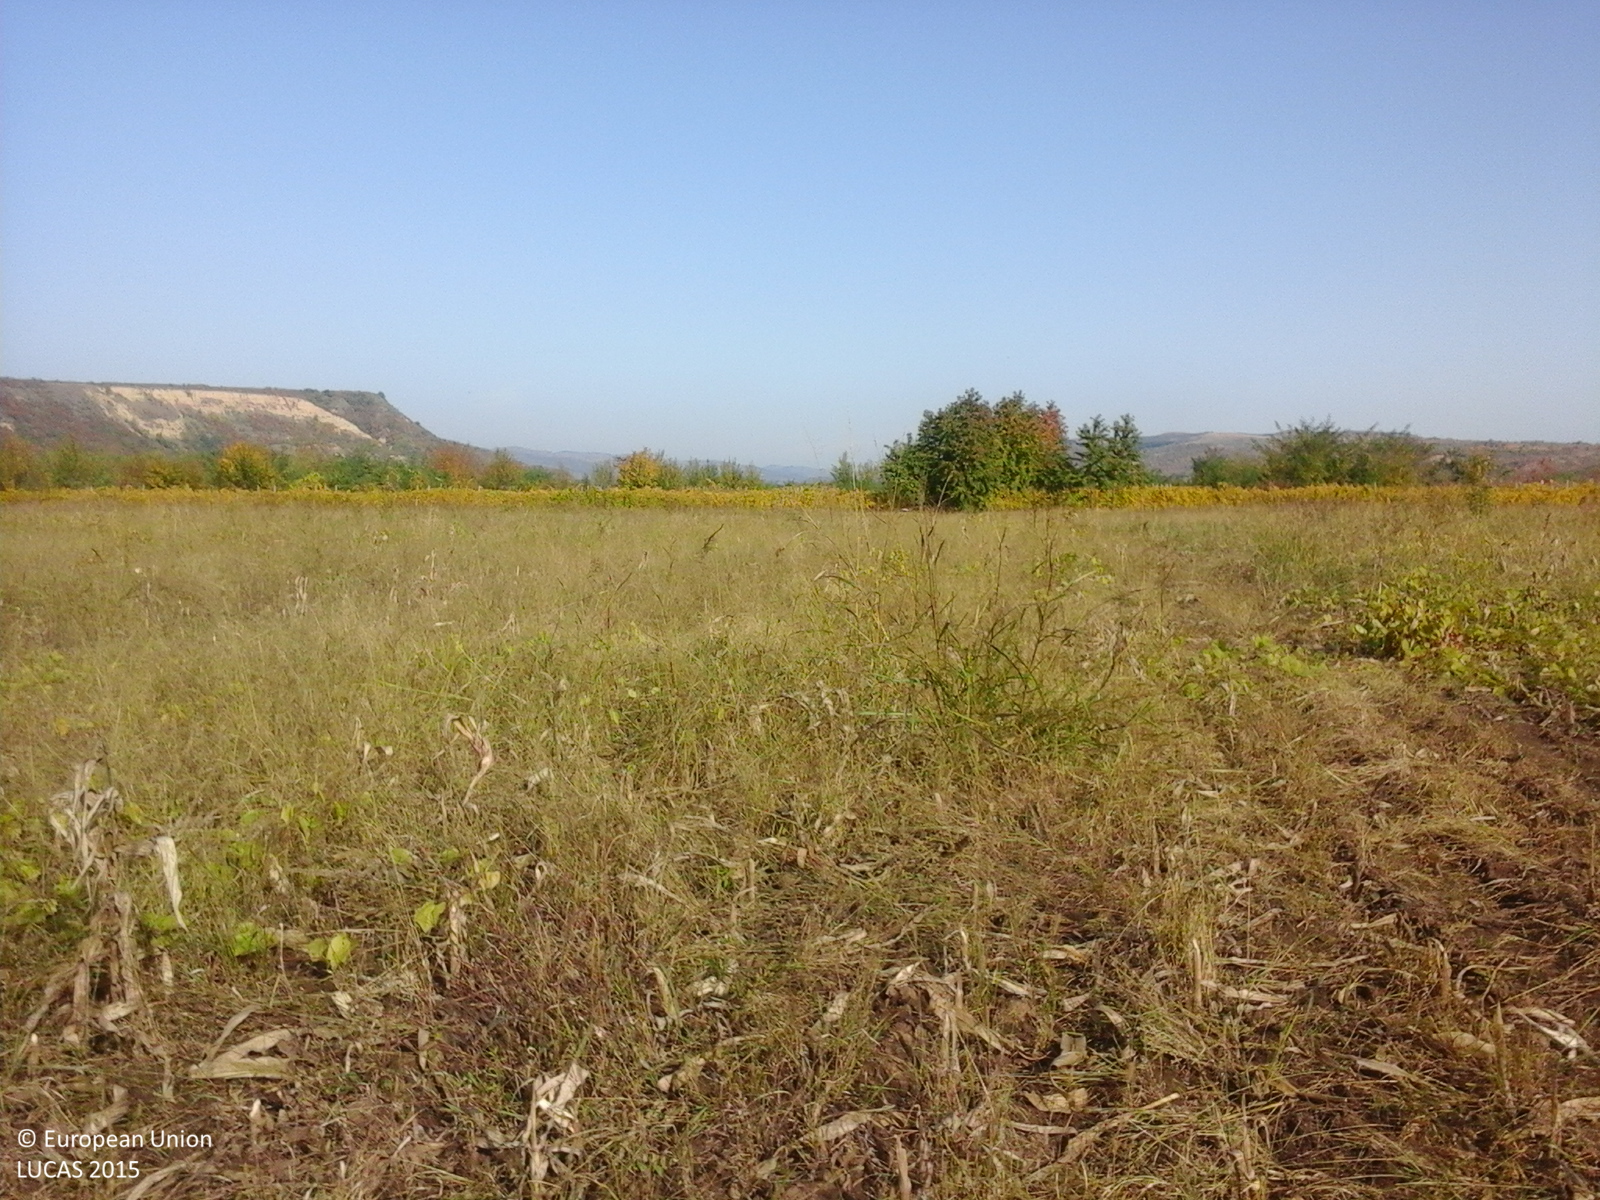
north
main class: Cropland
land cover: Maize
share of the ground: > 75 %
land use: Agriculture (excluding fallow land and kitchen gardens)
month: October
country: RO
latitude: 45.2383
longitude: 26.7539
